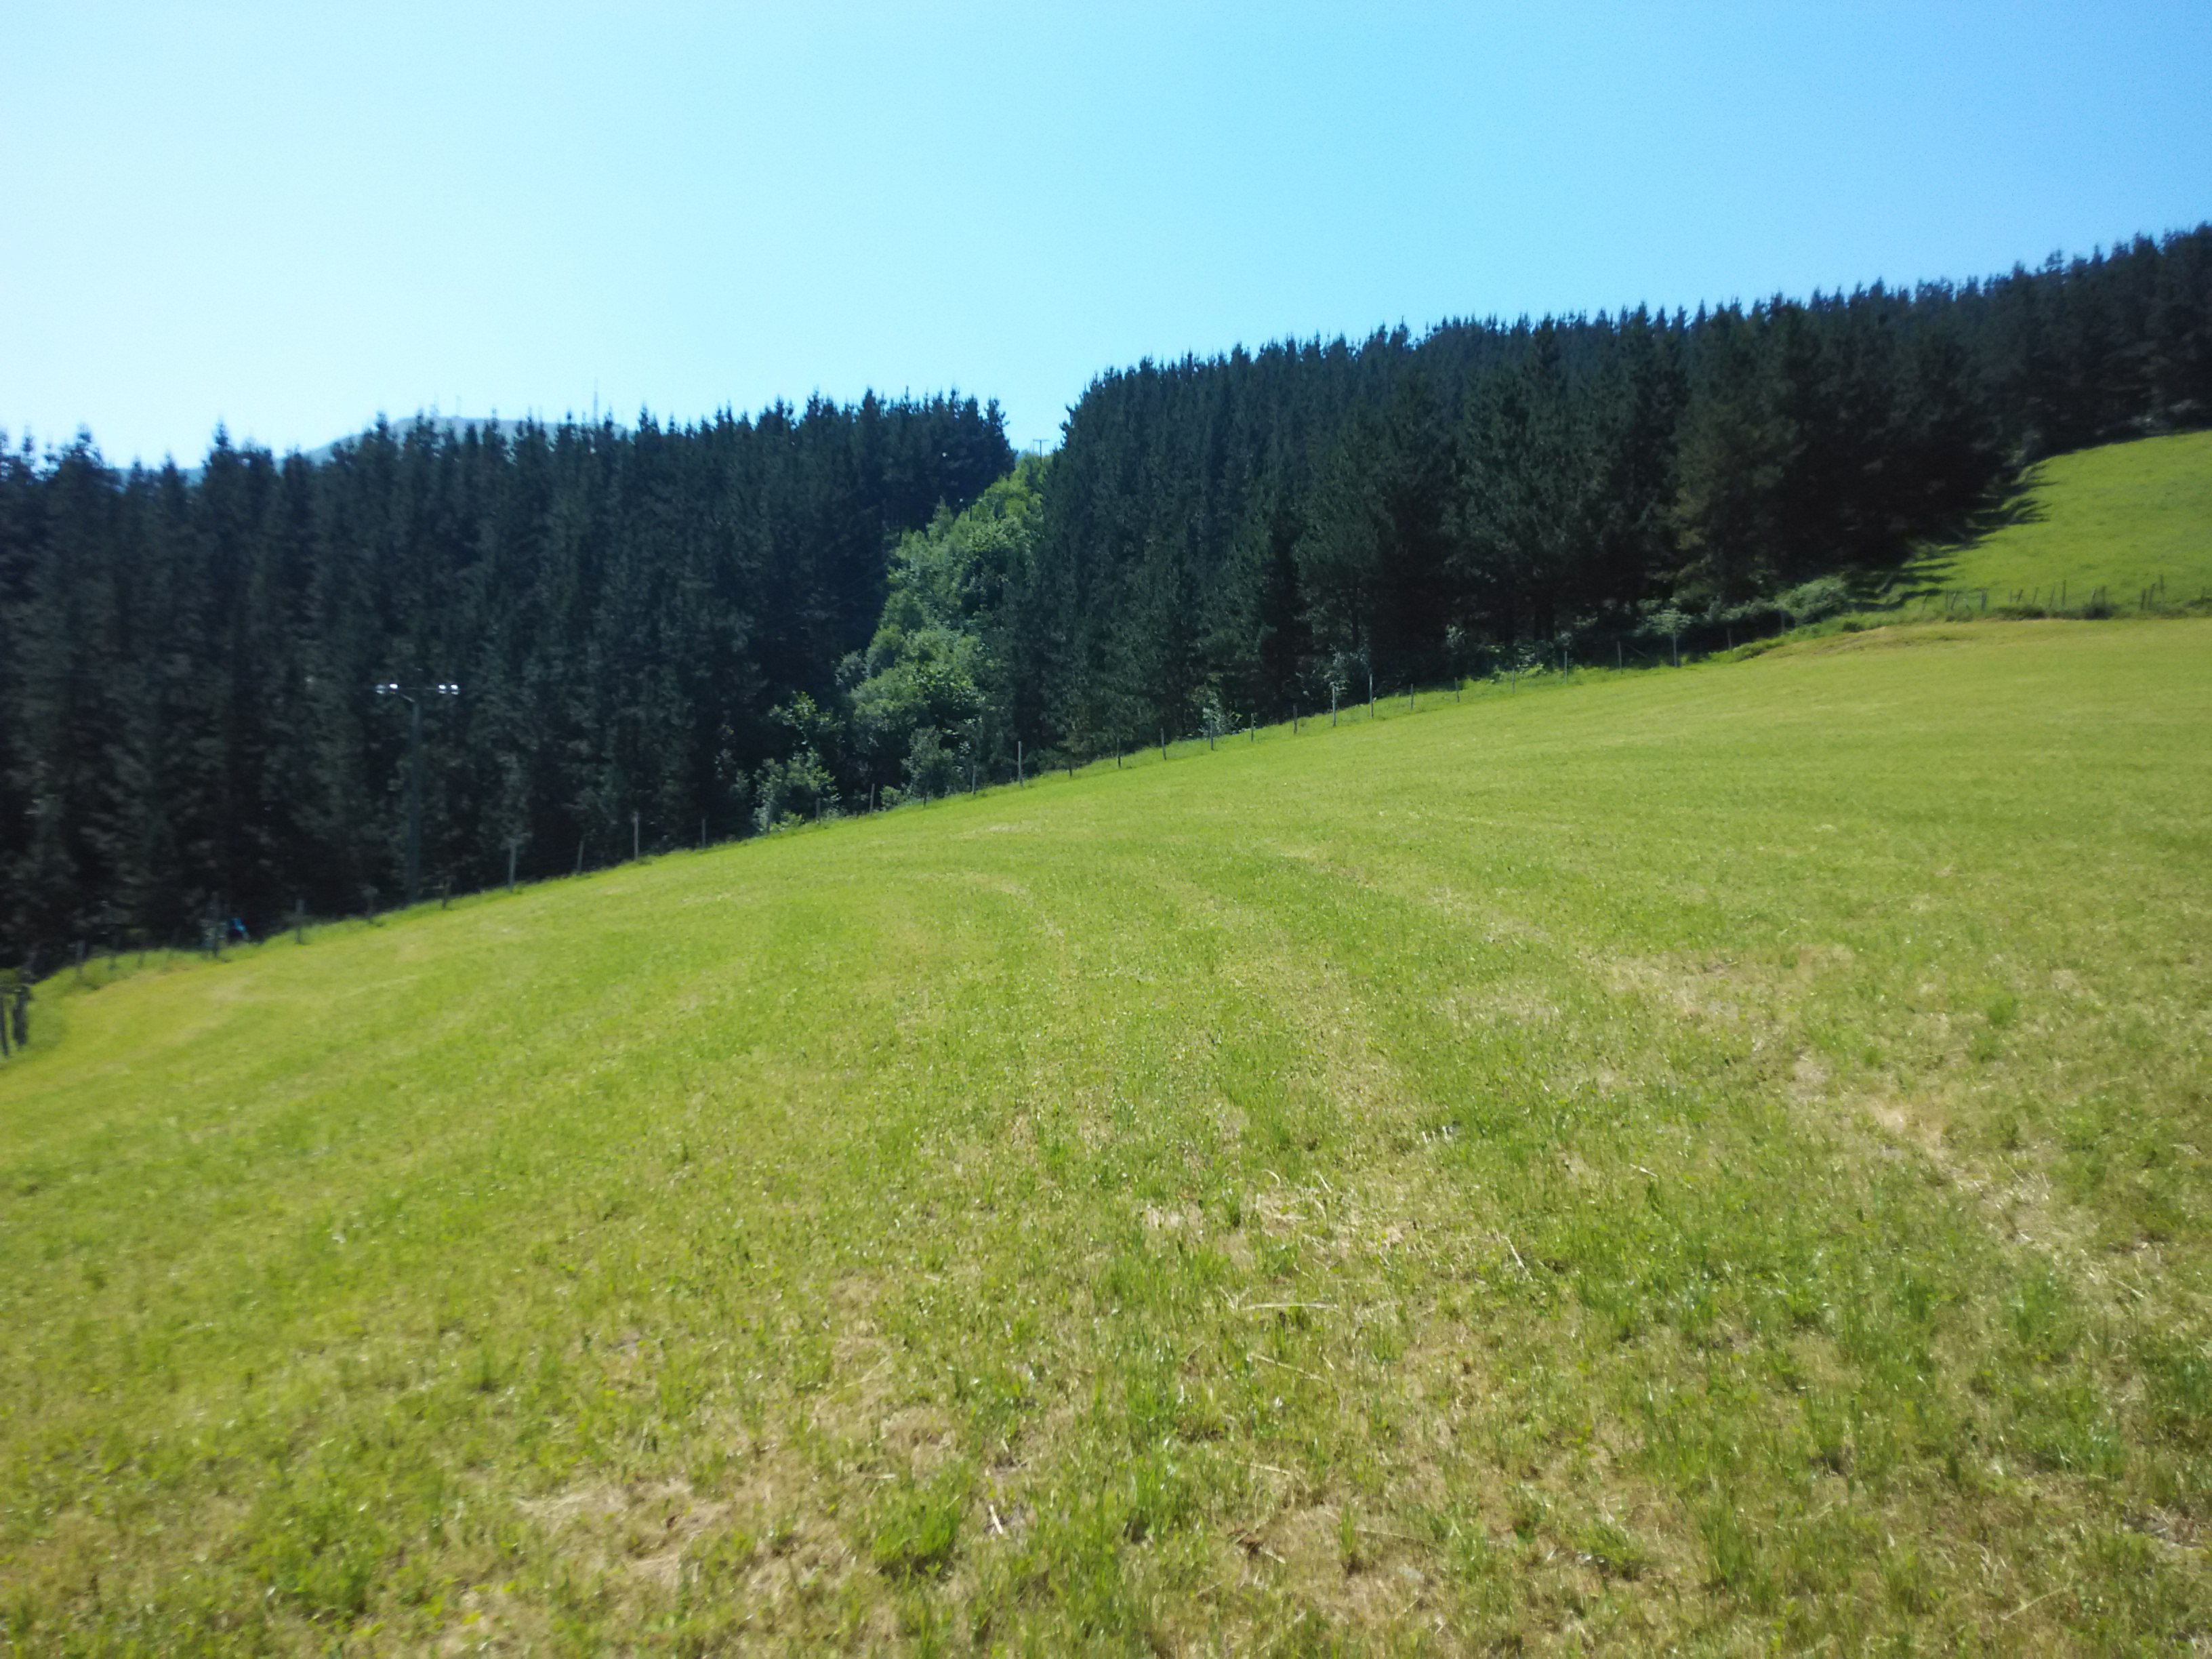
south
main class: Grassland
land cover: Grassland without tree/shrub cover
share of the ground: > 75 %
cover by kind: herbaceous plants 100 %
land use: Agriculture (excluding fallow land and kitchen gardens)
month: June
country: ES
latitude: 43.2502
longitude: -2.6050
